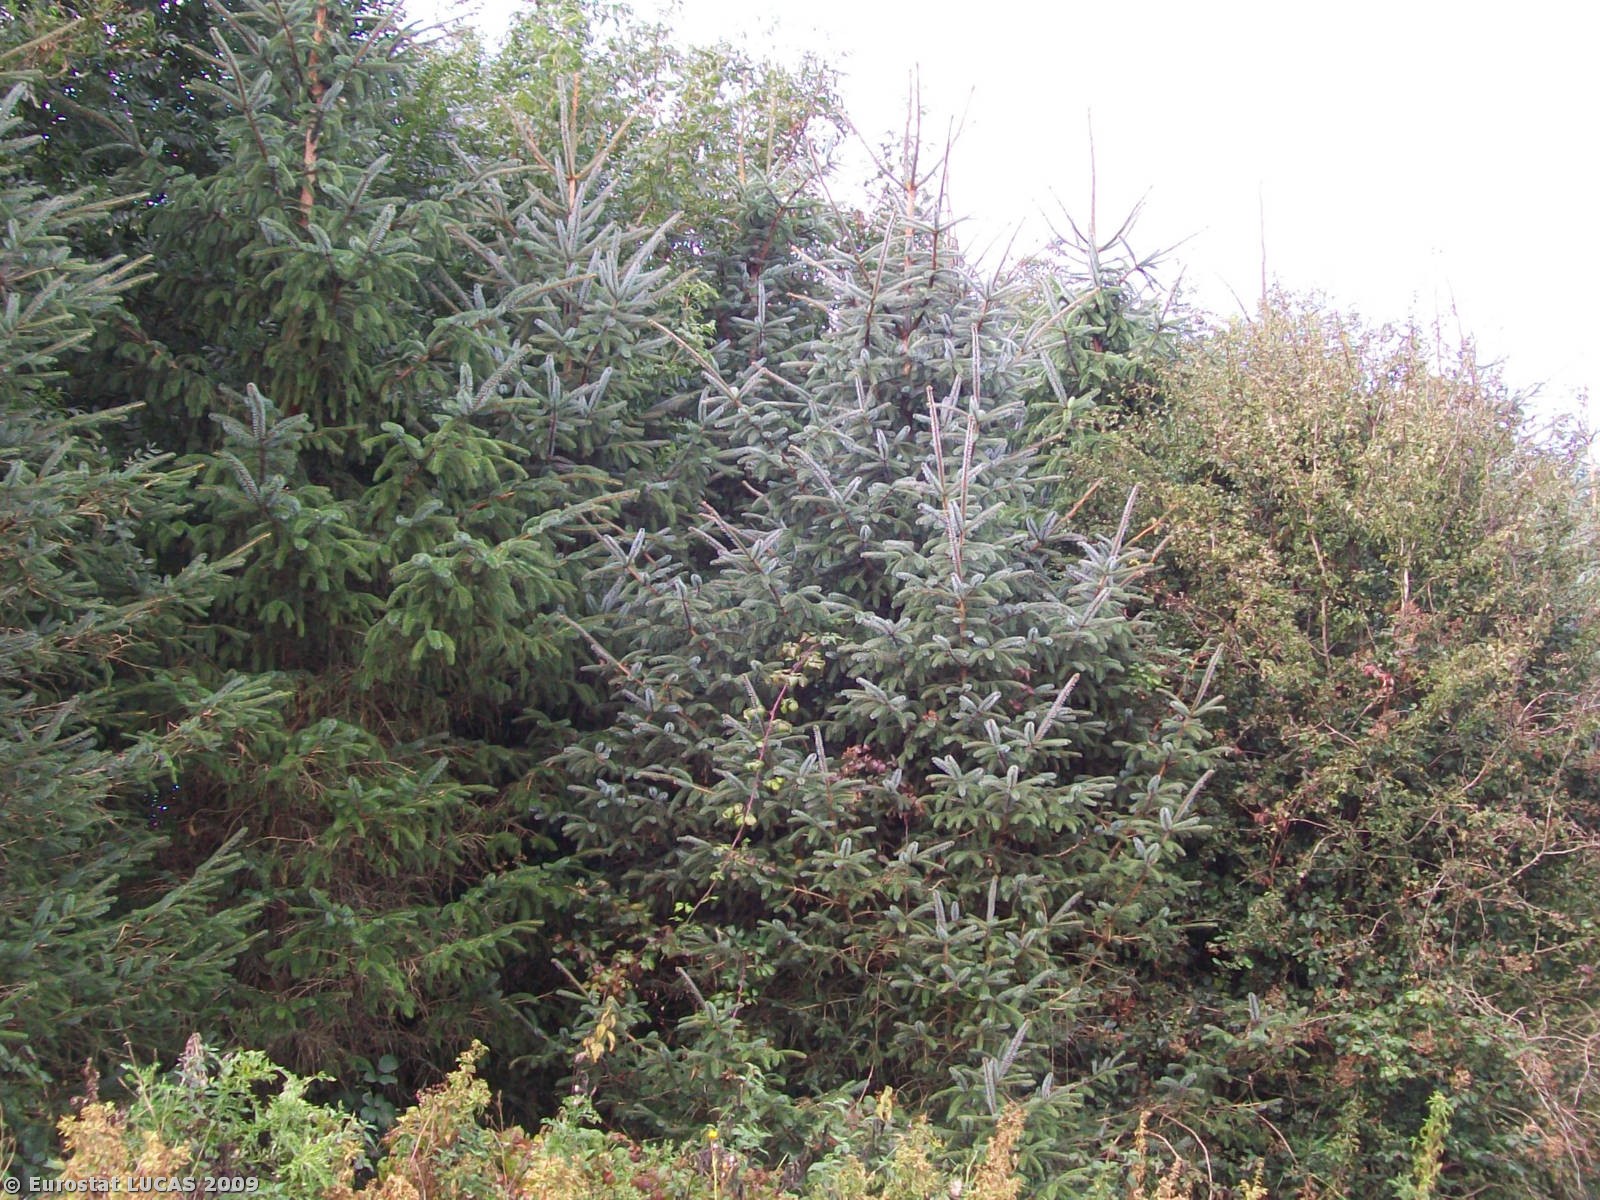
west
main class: Woodland
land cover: Coniferous woodland
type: plantations and self-sown exotic forest
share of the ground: > 75 %
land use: Forestry
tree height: > 5 m
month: September
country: IE
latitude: 53.1507
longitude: -7.9527
